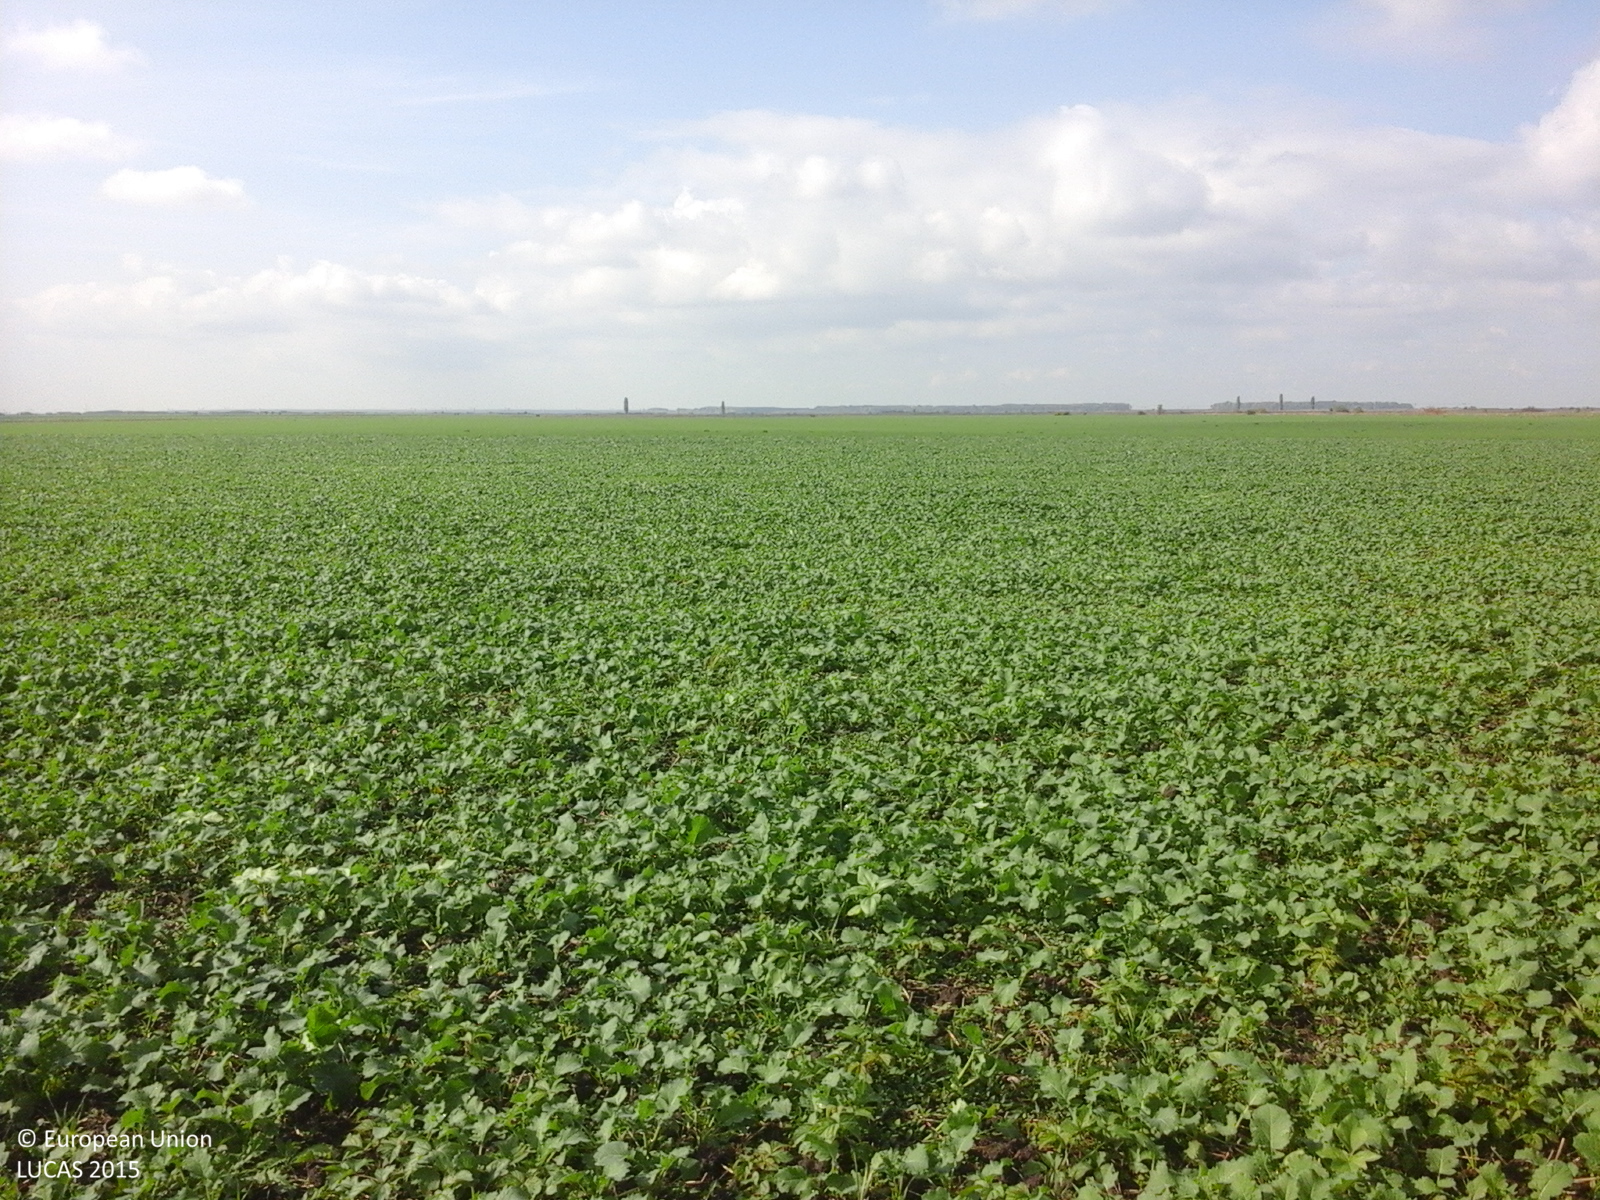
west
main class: Cropland
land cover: Rape and turnip rape
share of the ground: > 75 %
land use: Agriculture (excluding fallow land and kitchen gardens)
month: October
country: RO
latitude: 44.6409
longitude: 26.0027
